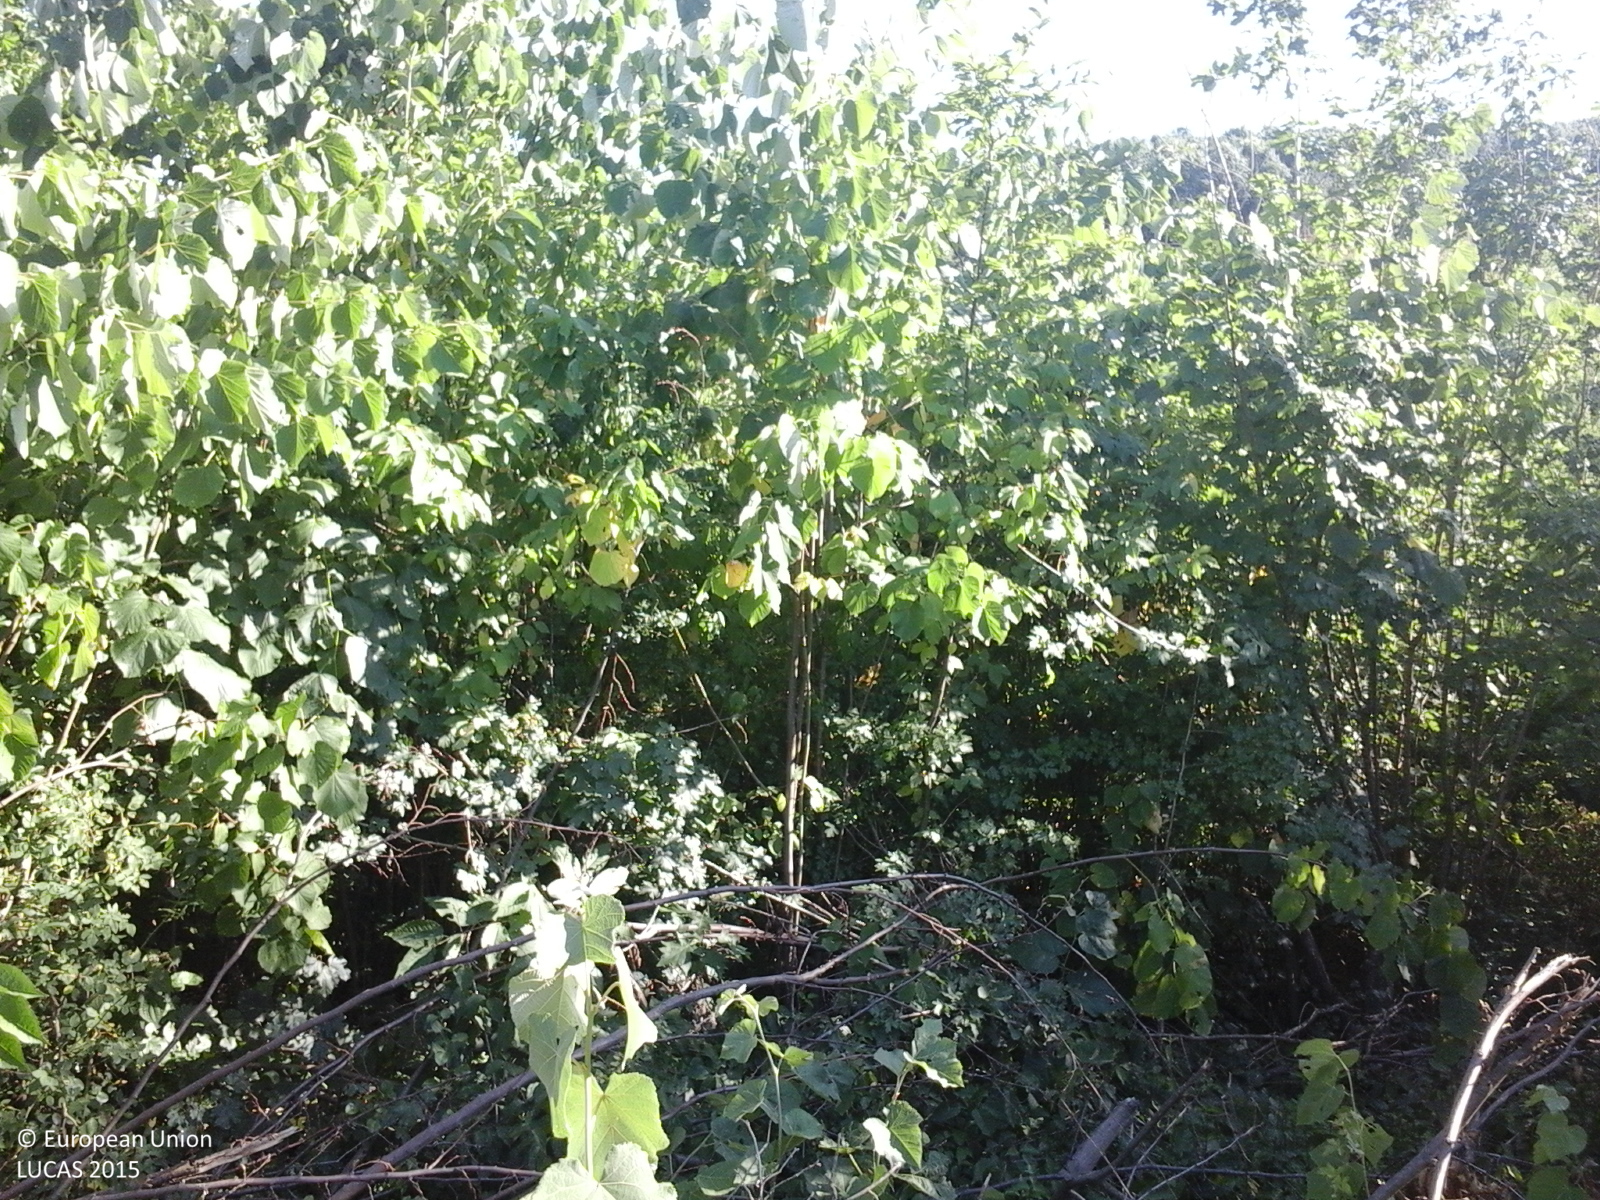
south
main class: Woodland
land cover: Broadleaved woodland
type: acidophilous oak and oak-birch forest
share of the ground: > 75 %
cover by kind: broadleaved forest trees 100 %
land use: Forestry
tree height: < 5 m
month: July
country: RO
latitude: 46.1455
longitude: 27.2812
